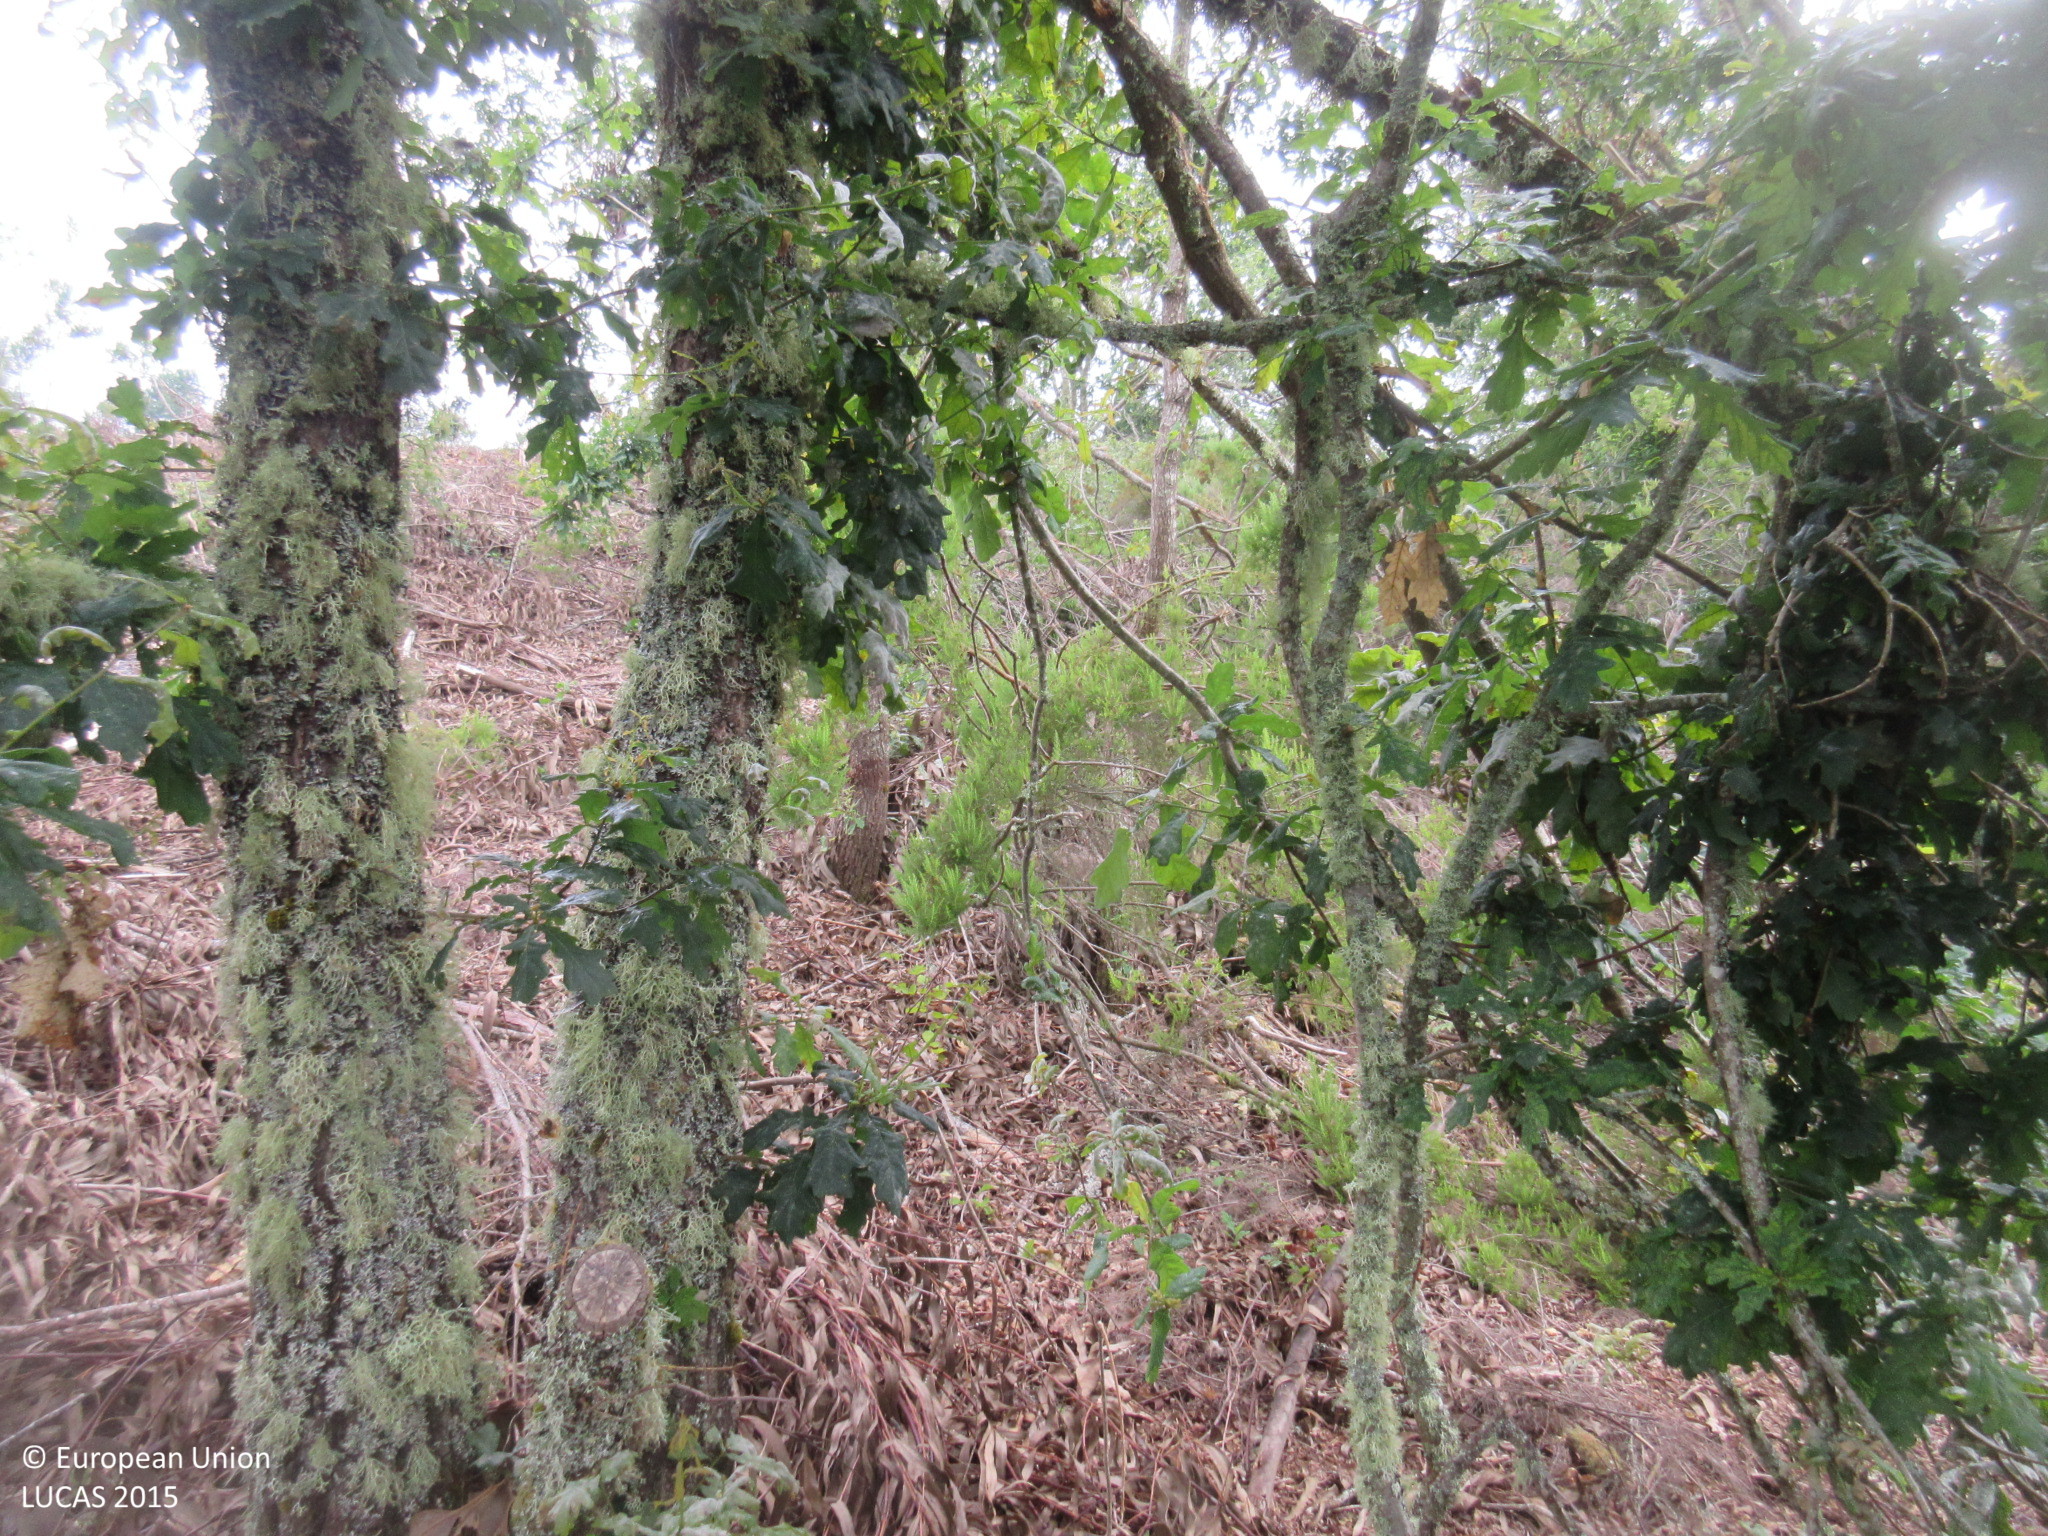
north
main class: Woodland
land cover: Broadleaved woodland
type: acidophilous oak and oak-birch forest
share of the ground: > 75 %
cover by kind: broadleaved forest trees 90 %, shrubs 10 %
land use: Forestry
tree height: > 5 m
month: June
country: ES
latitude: 42.9660
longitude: -7.1436
